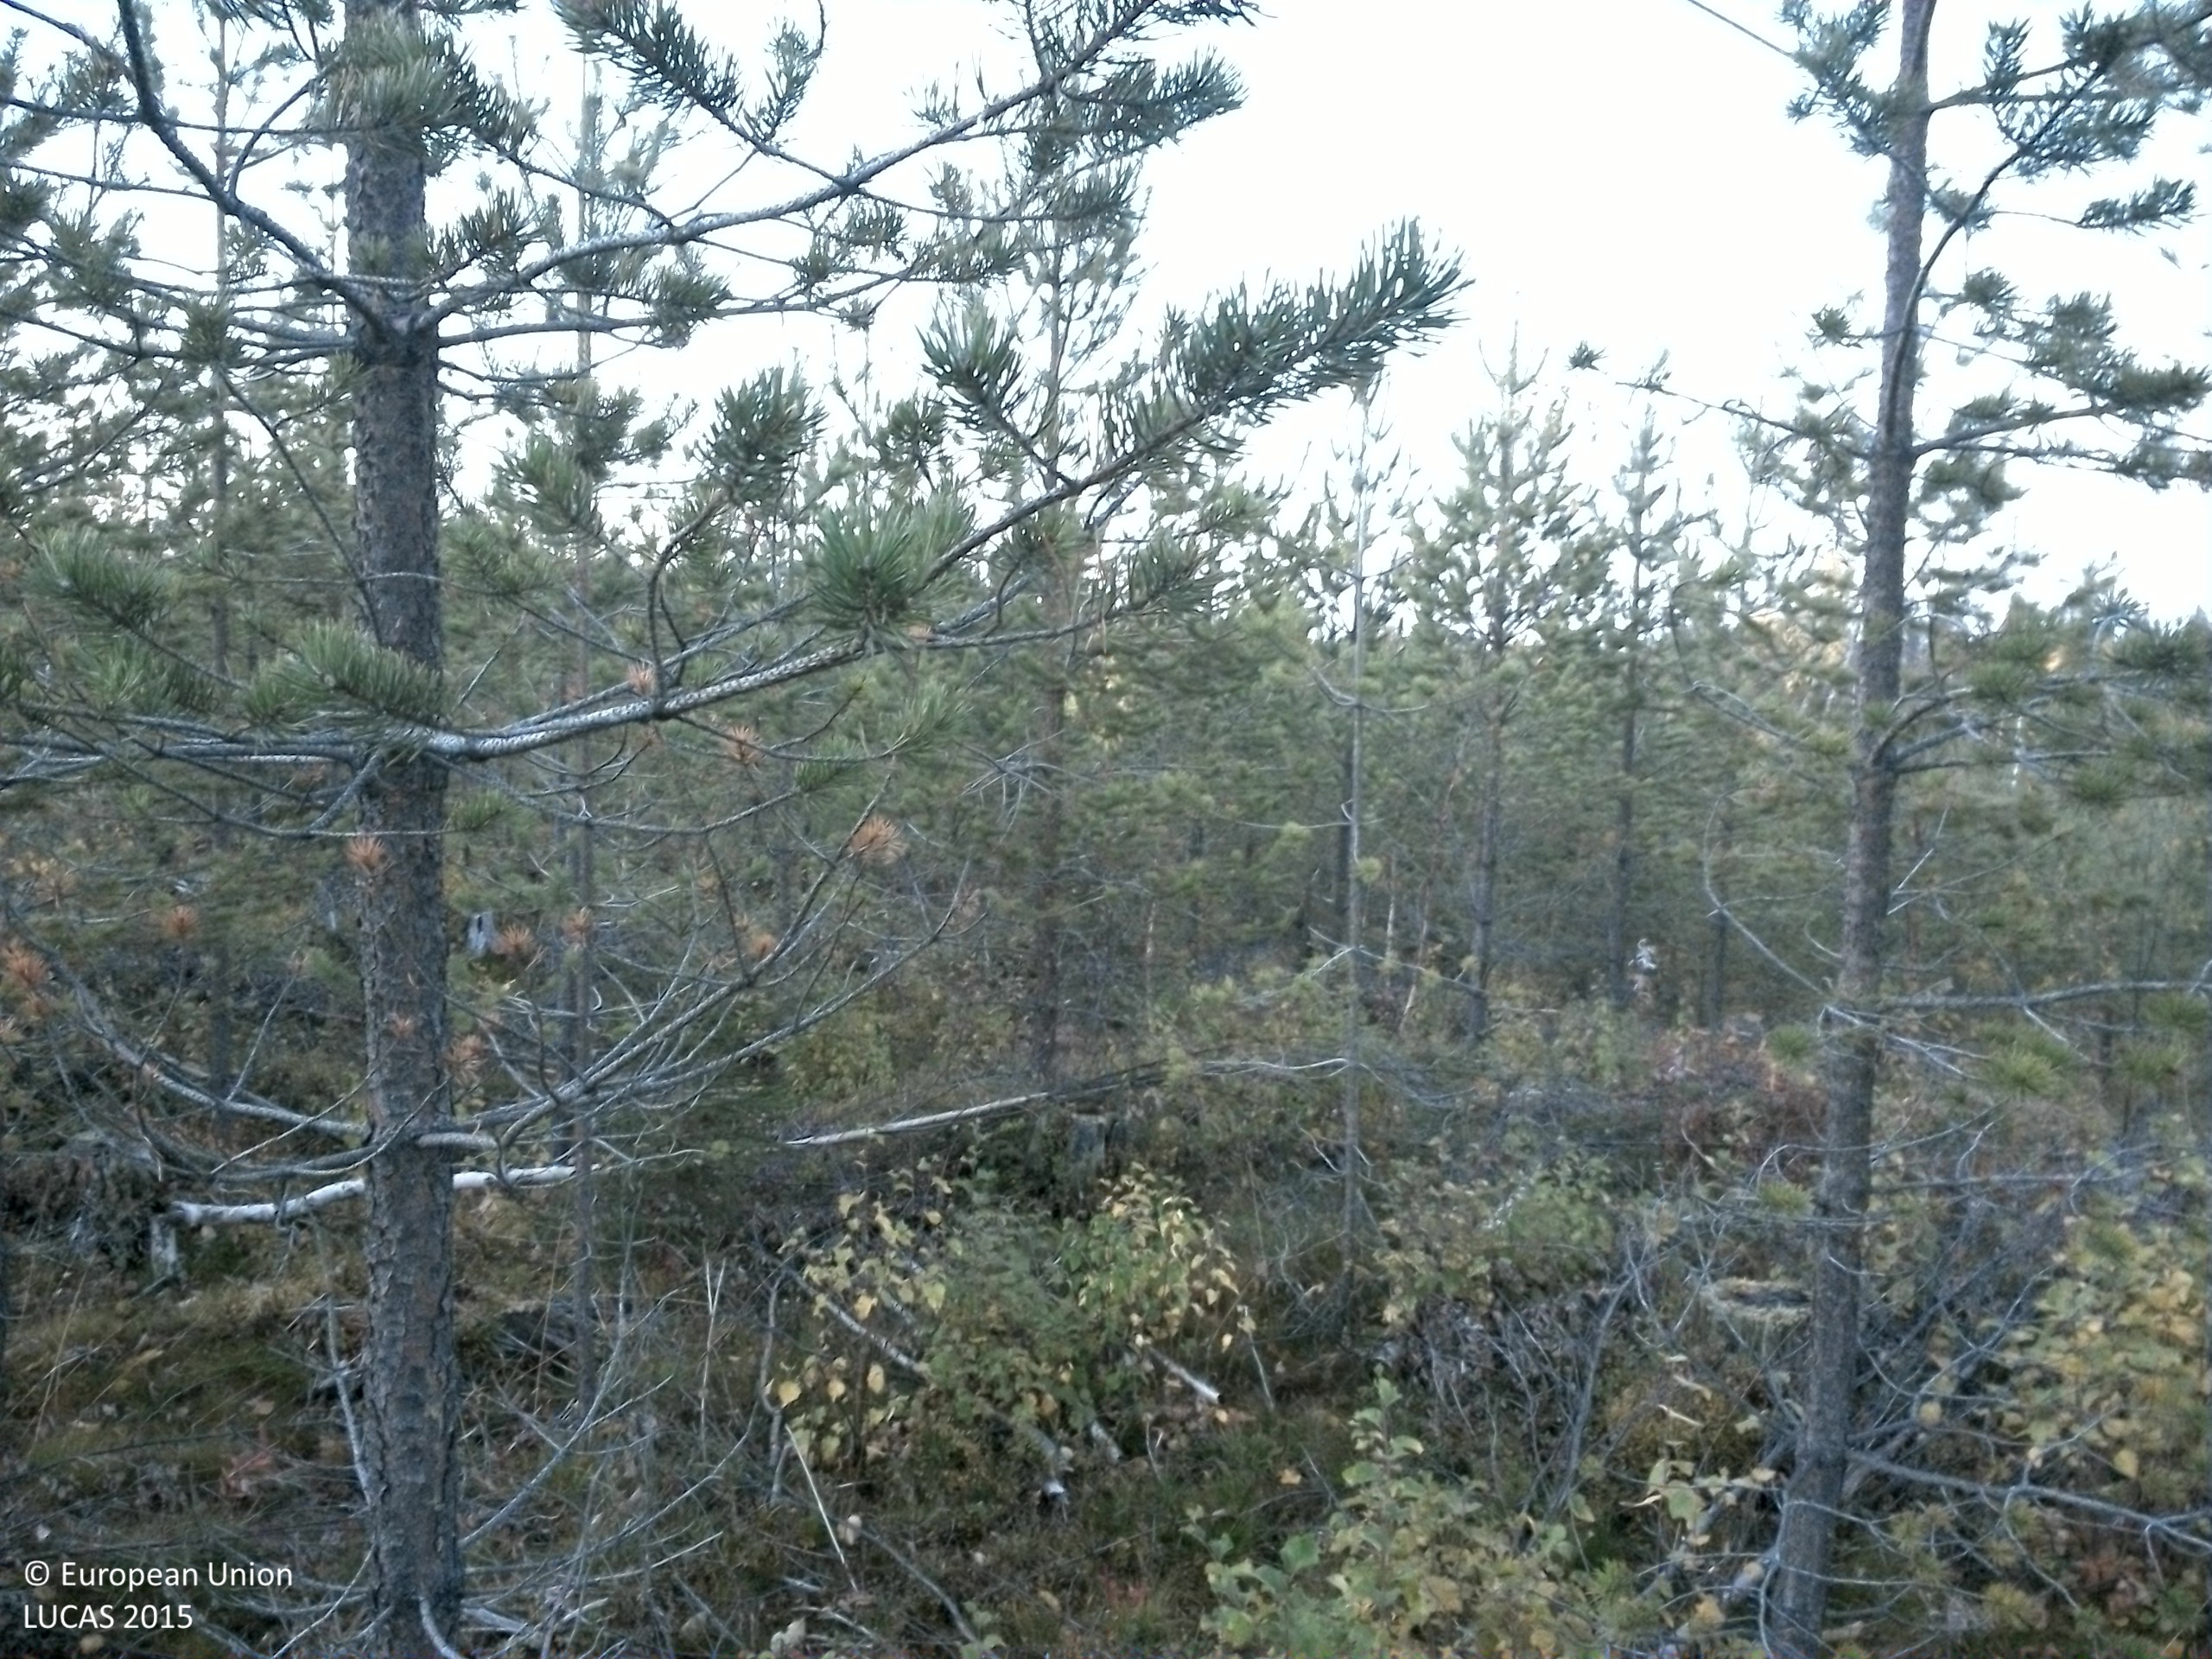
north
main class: Woodland
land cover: Pine dominated coniferous woodland
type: boreal forest
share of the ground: 25 - 50 %
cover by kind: coniferous forest trees 35 %, shrubs 30 %, lichens and mosses 15 %, broadleaved forest trees 10 %, herbaceous plants 10 %
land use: Forestry
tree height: < 5 m
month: October
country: SE
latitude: 64.3166
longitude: 16.1116
